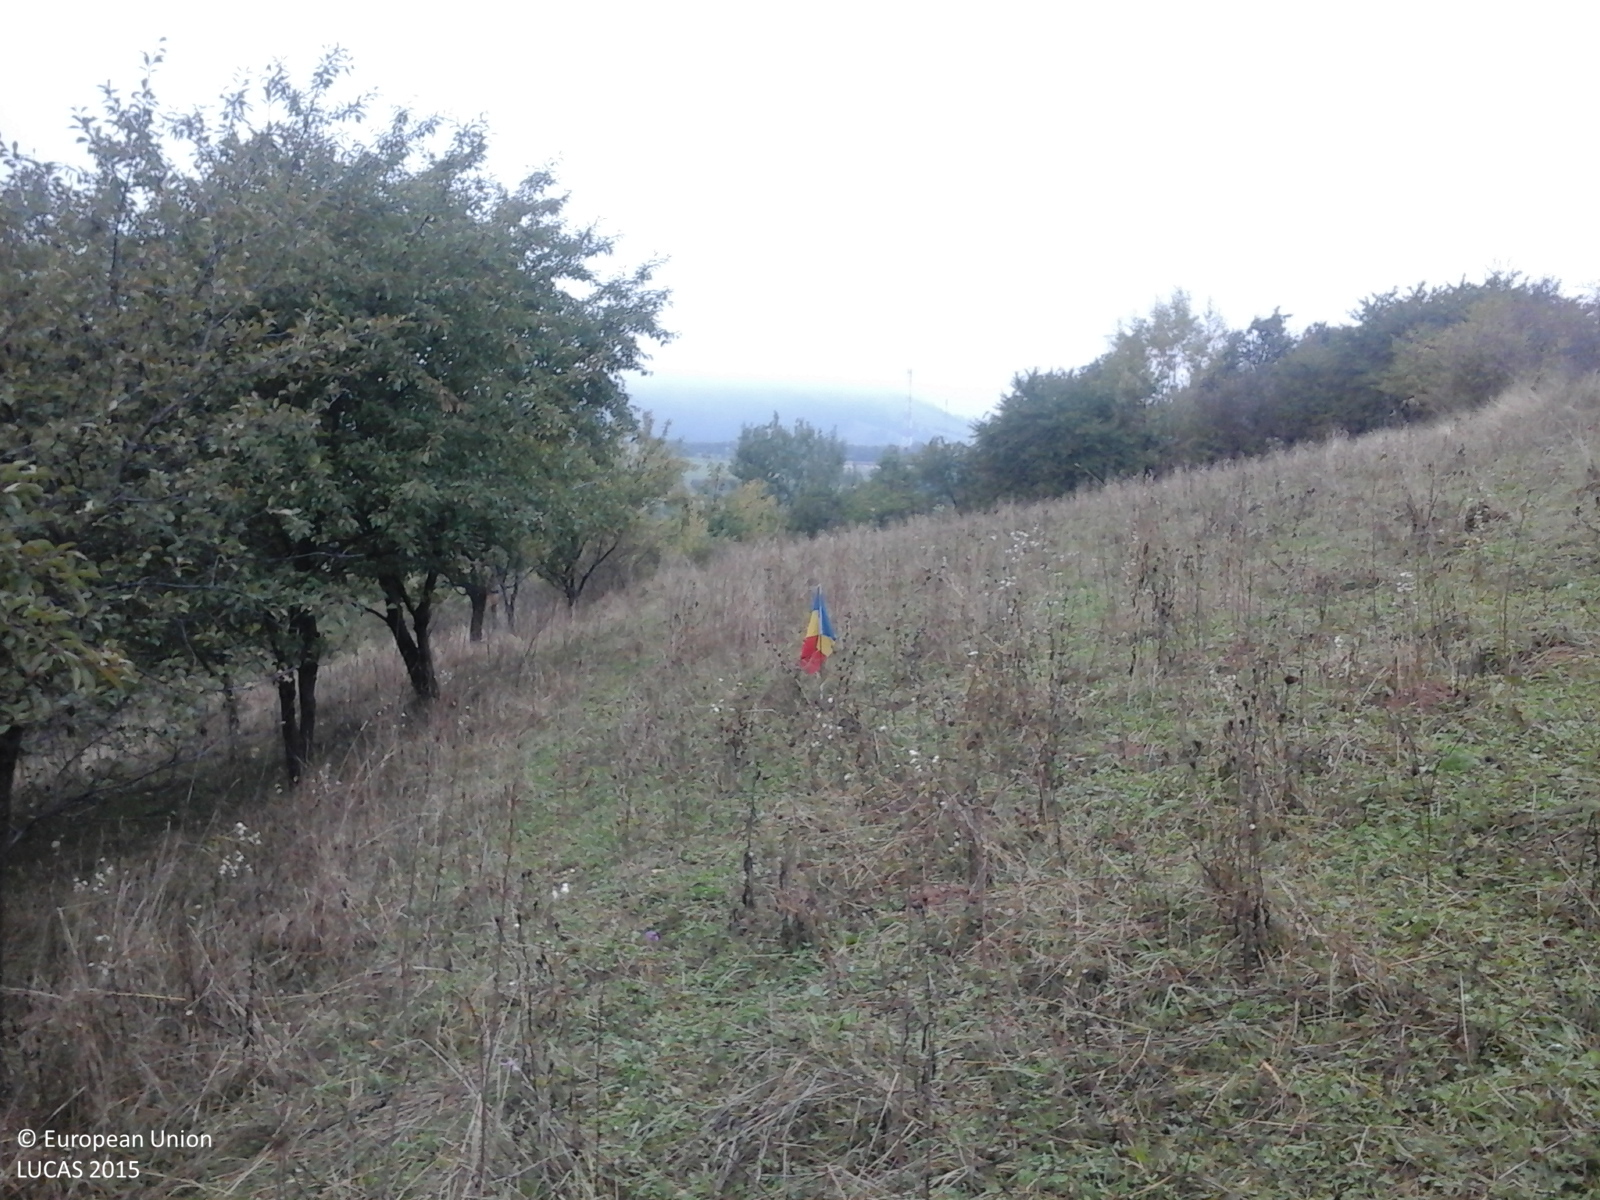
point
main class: Grassland
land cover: Spontaneously vegetated surfaces
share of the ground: > 75 %
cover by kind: herbaceous plants 100 %
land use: Fallow land
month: October
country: RO
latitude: 45.7057
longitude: 24.0864
